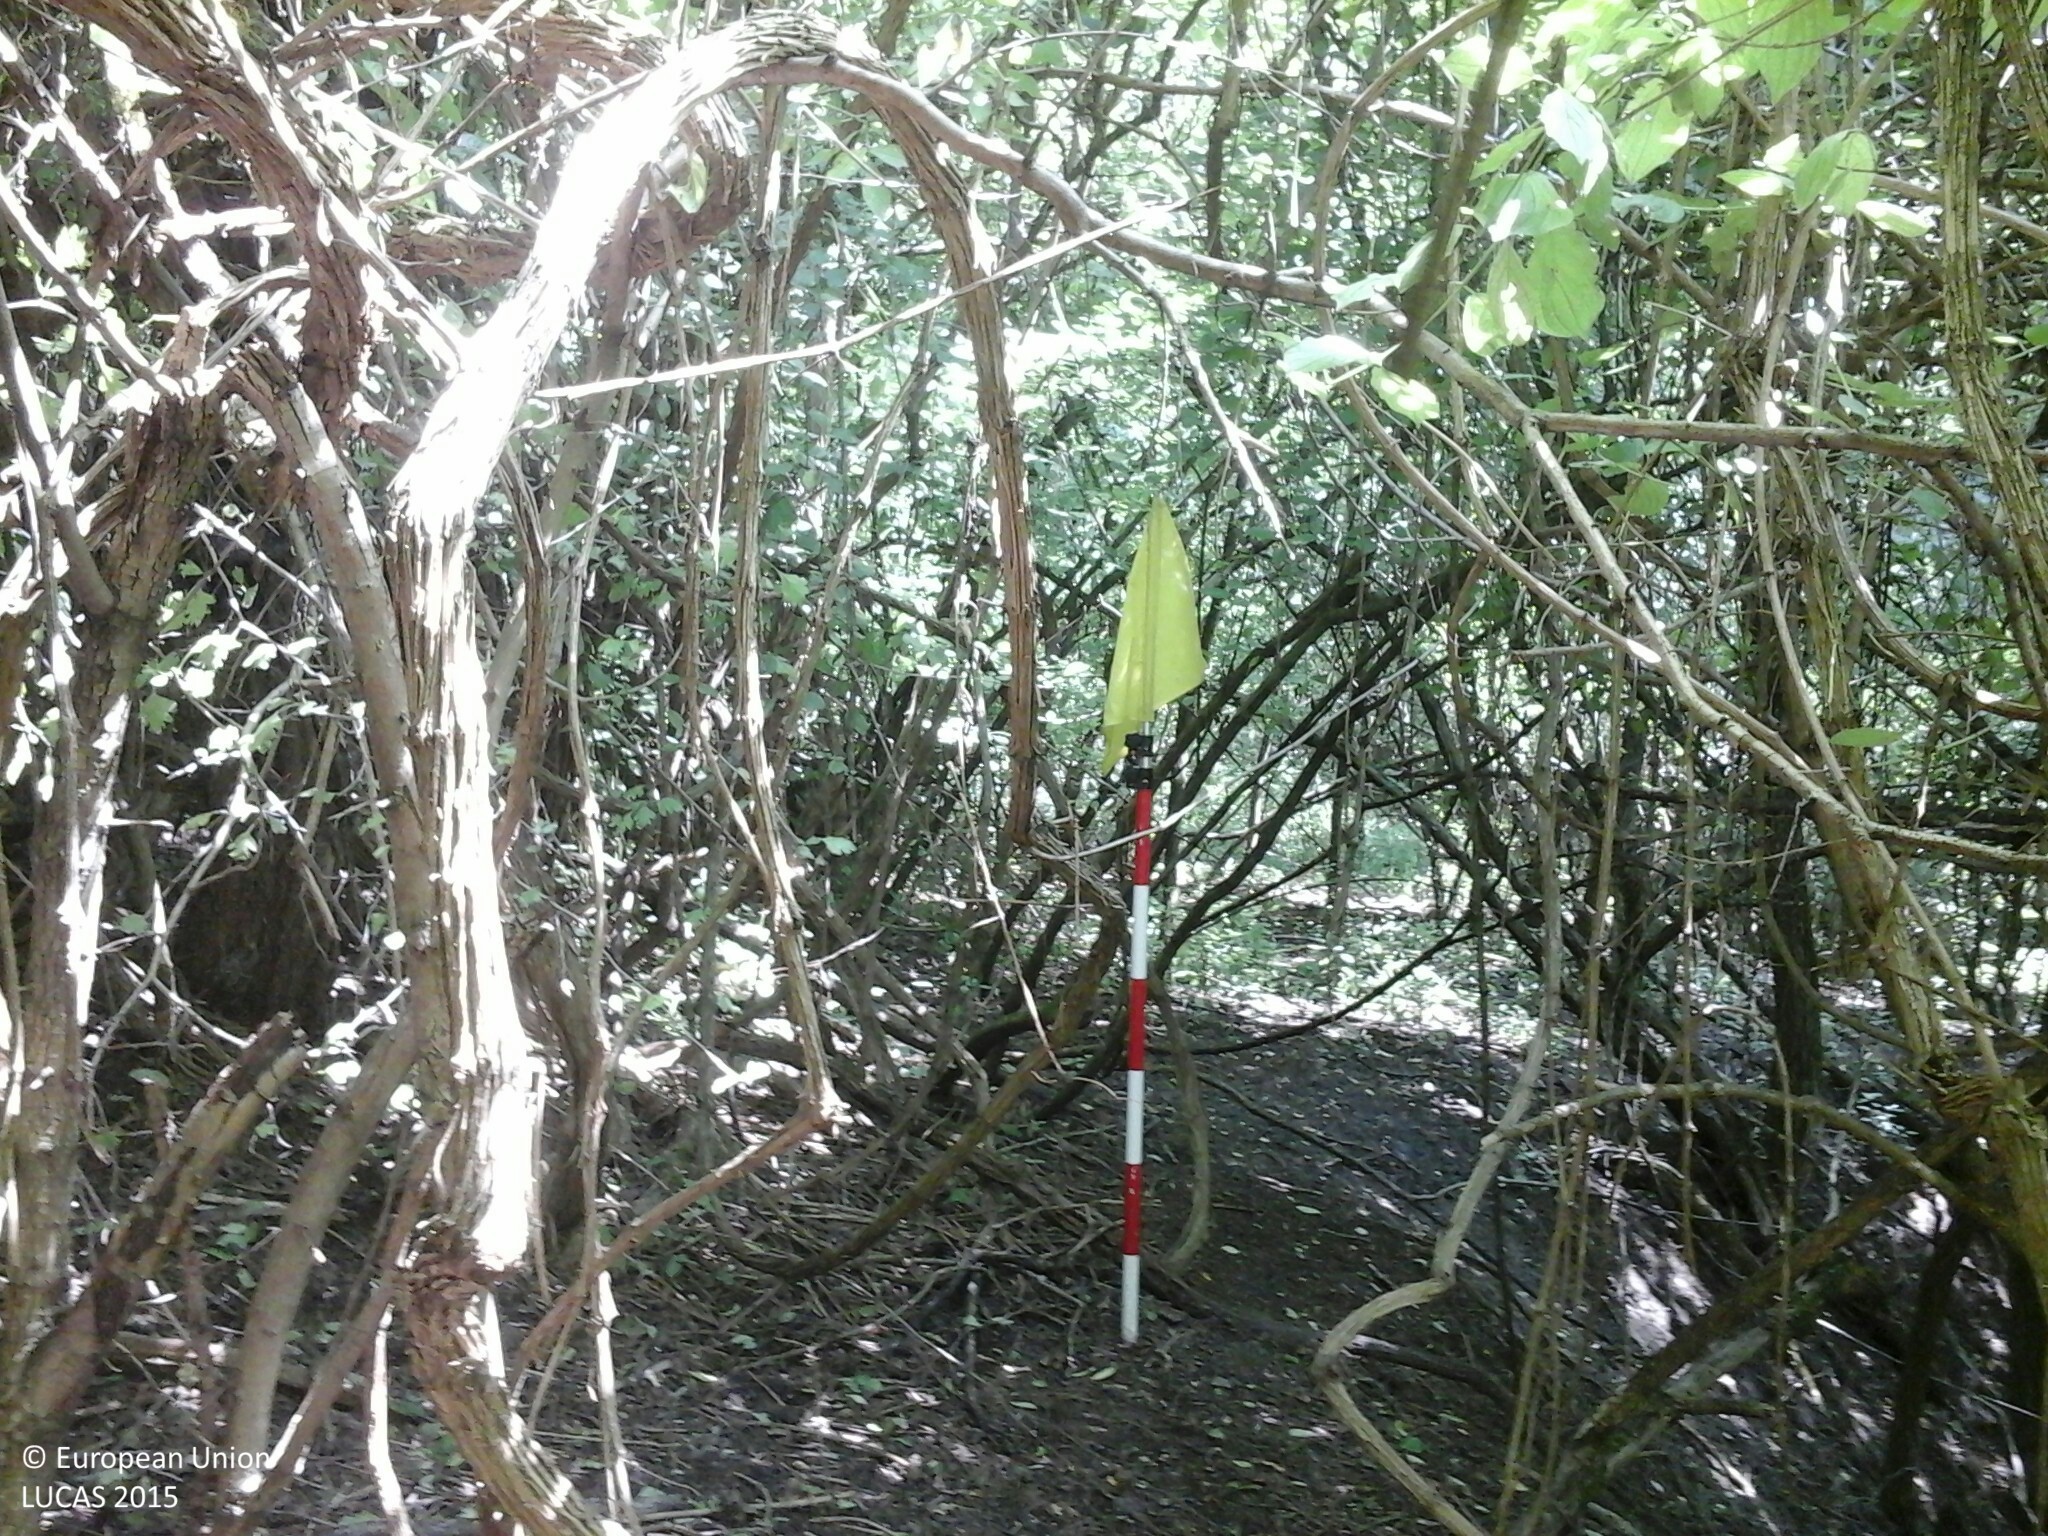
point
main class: Woodland
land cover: Broadleaved woodland
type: acidophilous oak and oak-birch forest
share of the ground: > 75 %
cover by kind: broadleaved forest trees 90 %, shrubs 10 %
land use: Forestry
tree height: > 5 m
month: August
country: HU
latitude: 48.1302
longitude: 20.3919
